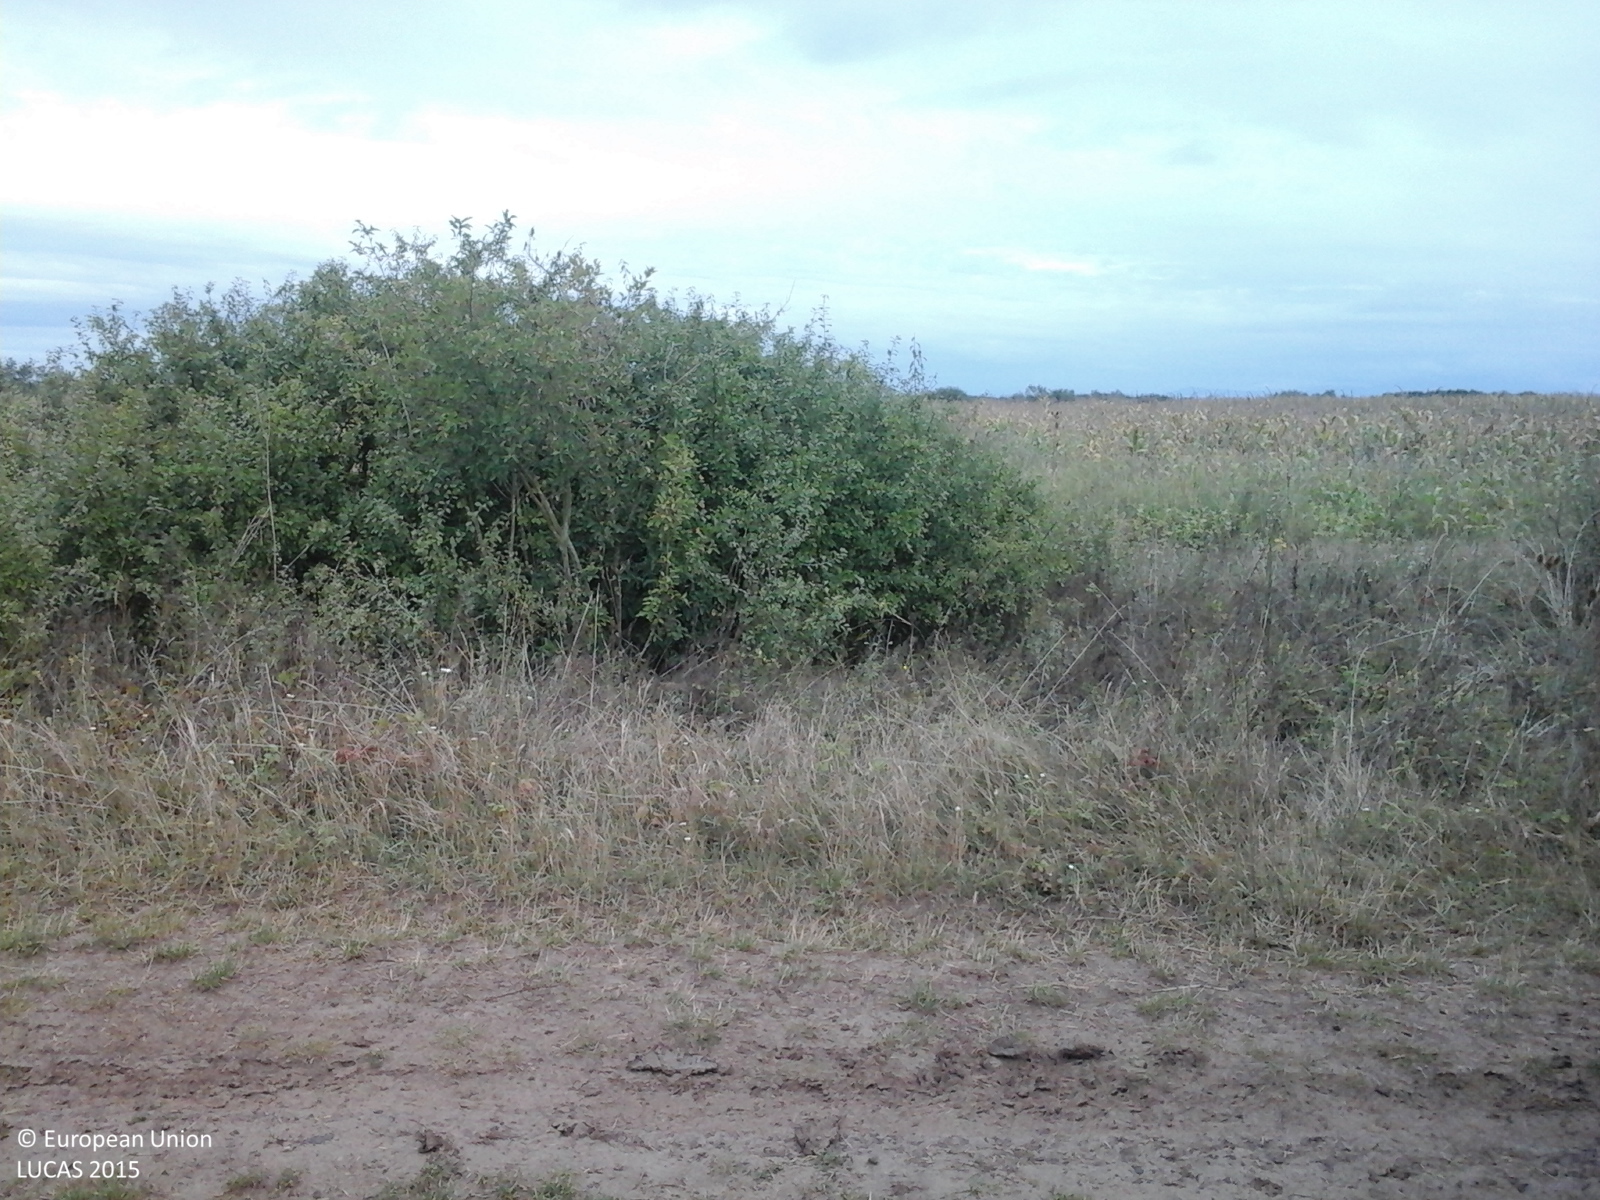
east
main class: Cropland
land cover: Maize
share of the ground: > 75 %
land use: Agriculture (excluding fallow land and kitchen gardens)
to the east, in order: Maize; Shruby margins; Tracks; Shruby margins; Ditches and canals; Shruby margins; Maize
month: September
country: RO
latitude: 46.7552
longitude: 21.7594
